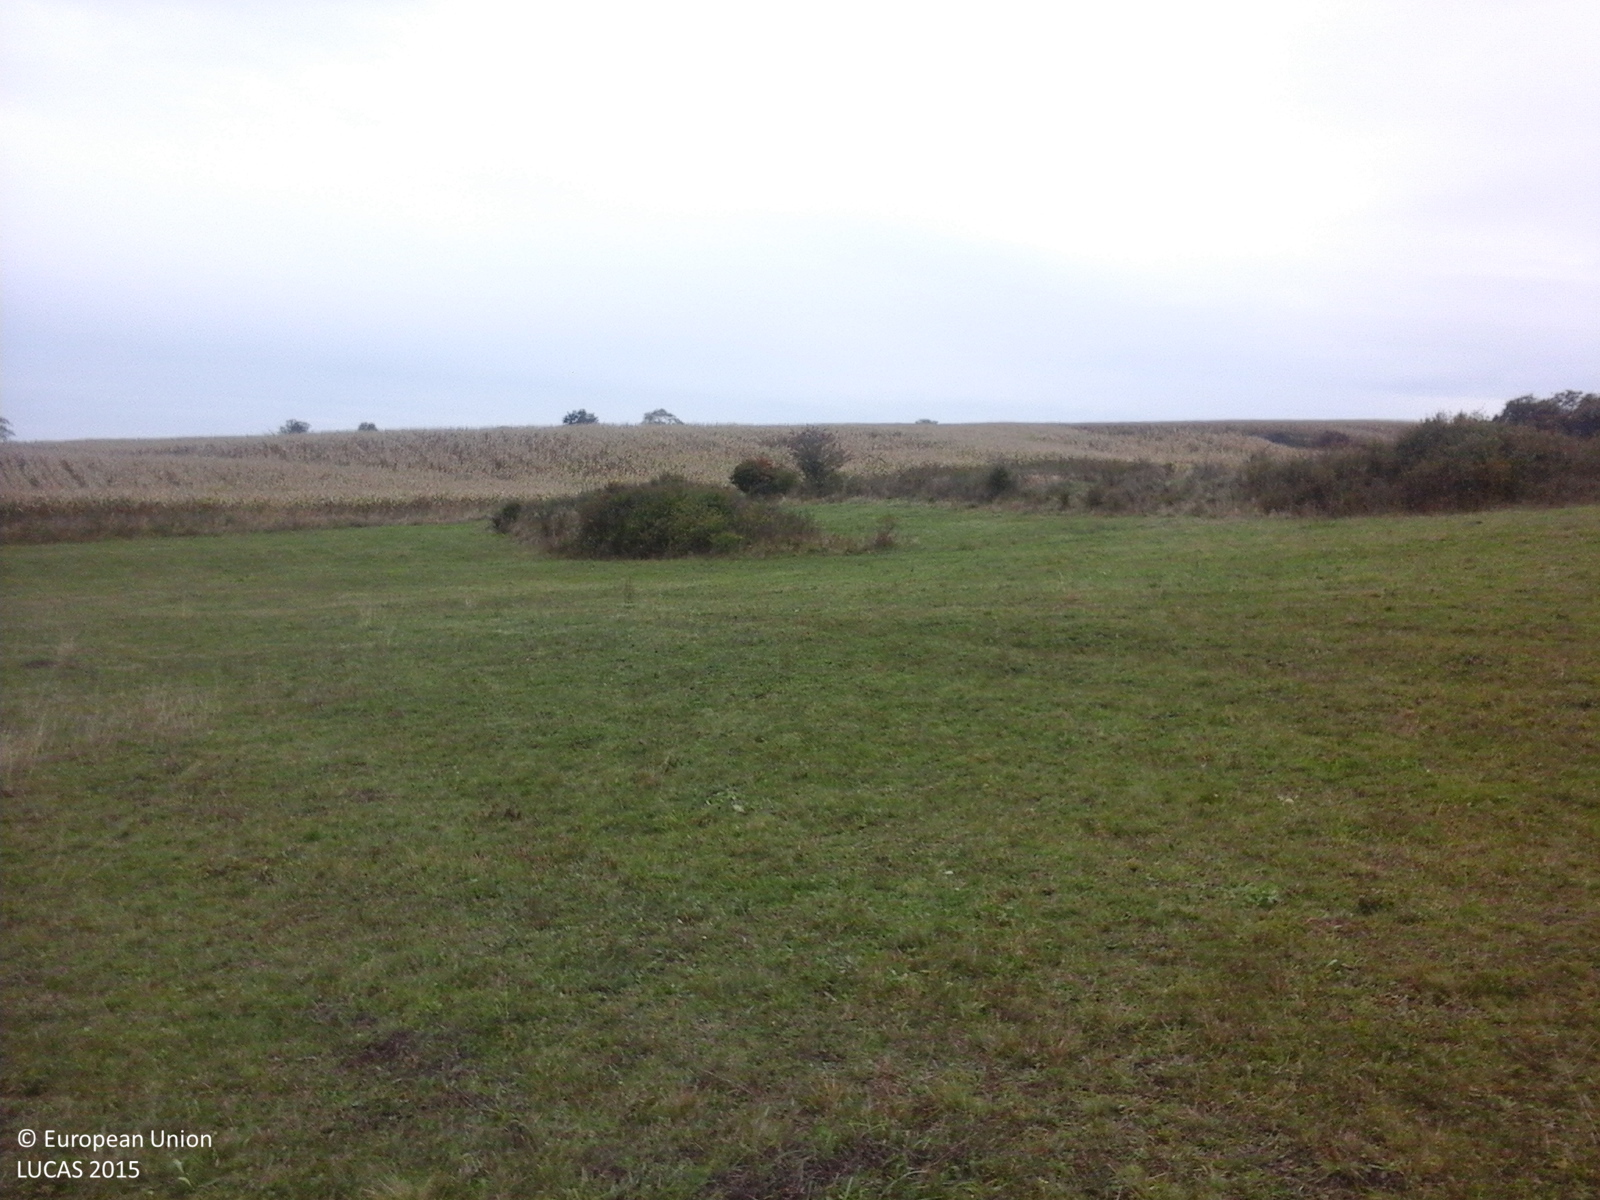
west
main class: Grassland
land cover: Grassland without tree/shrub cover
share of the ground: > 75 %
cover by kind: herbaceous plants 100 %
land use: Agriculture (excluding fallow land and kitchen gardens)
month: October
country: RO
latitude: 46.0521
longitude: 24.8904
